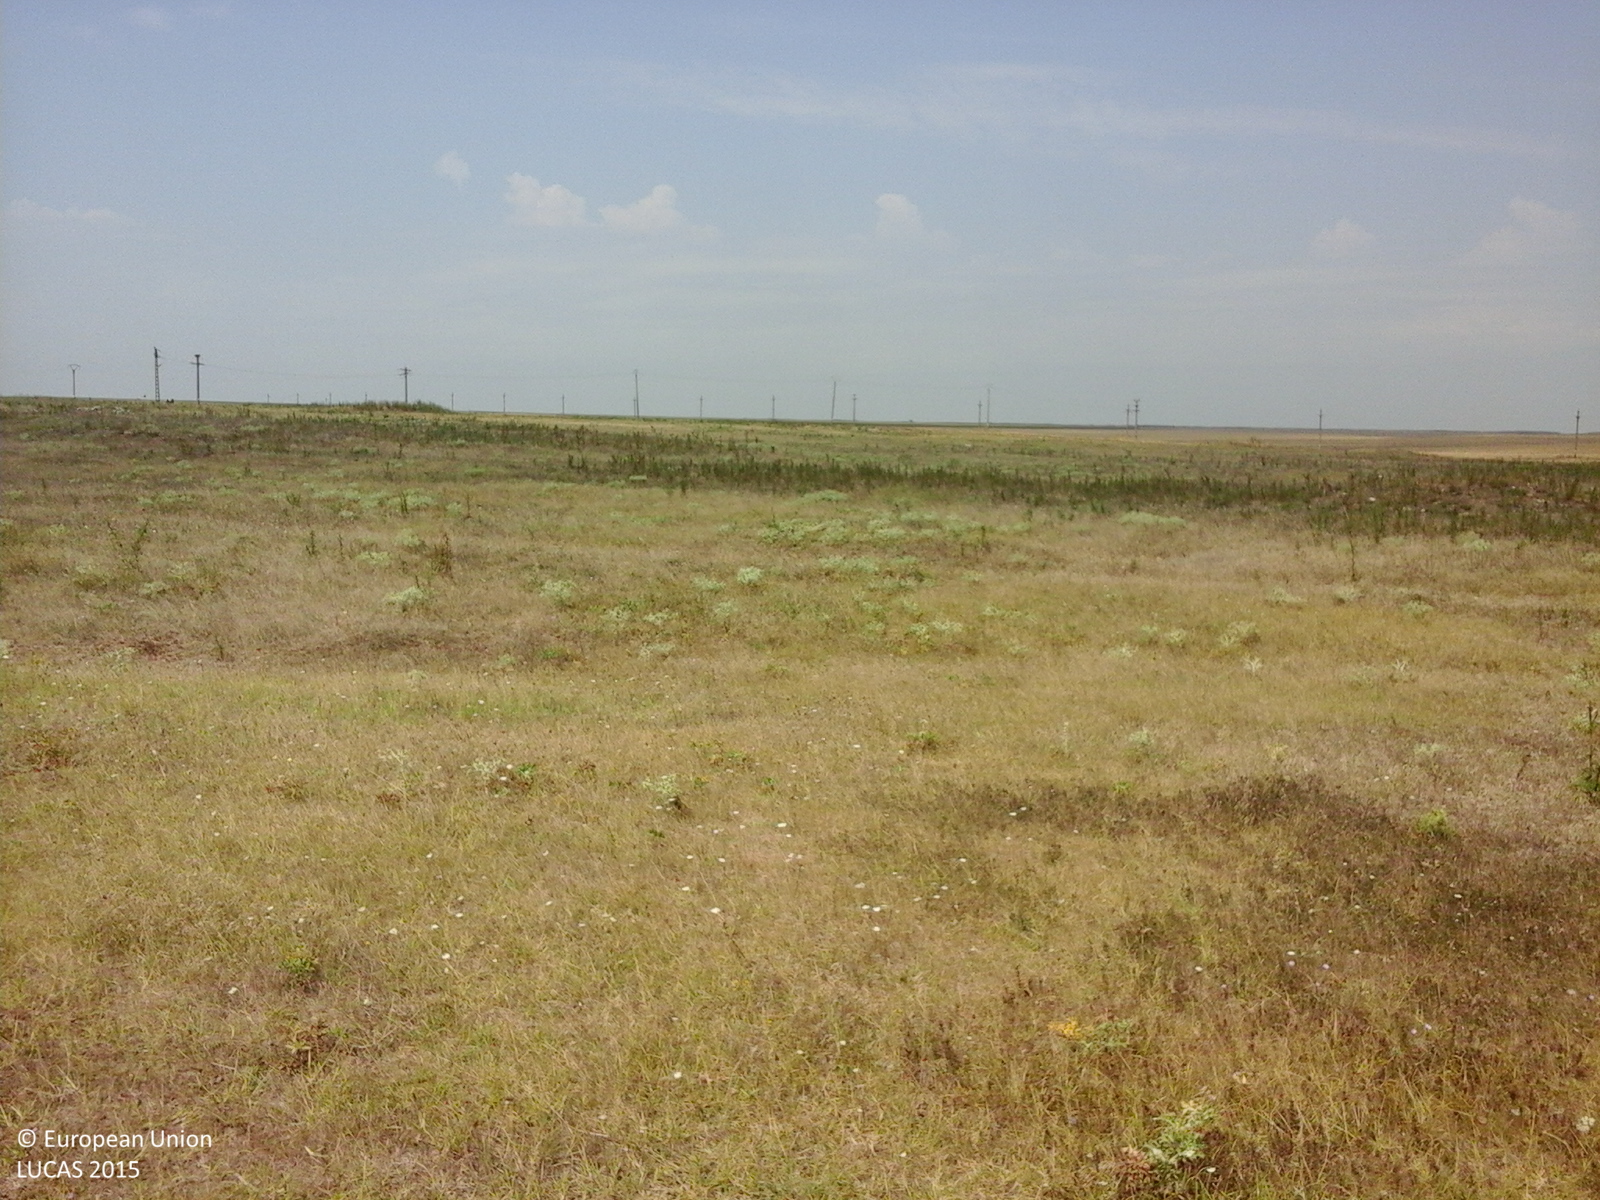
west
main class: Grassland
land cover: Spontaneously vegetated surfaces
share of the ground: > 75 %
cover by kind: herbaceous plants 100 %
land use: Fallow land
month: August
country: RO
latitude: 43.7879
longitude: 28.3400
